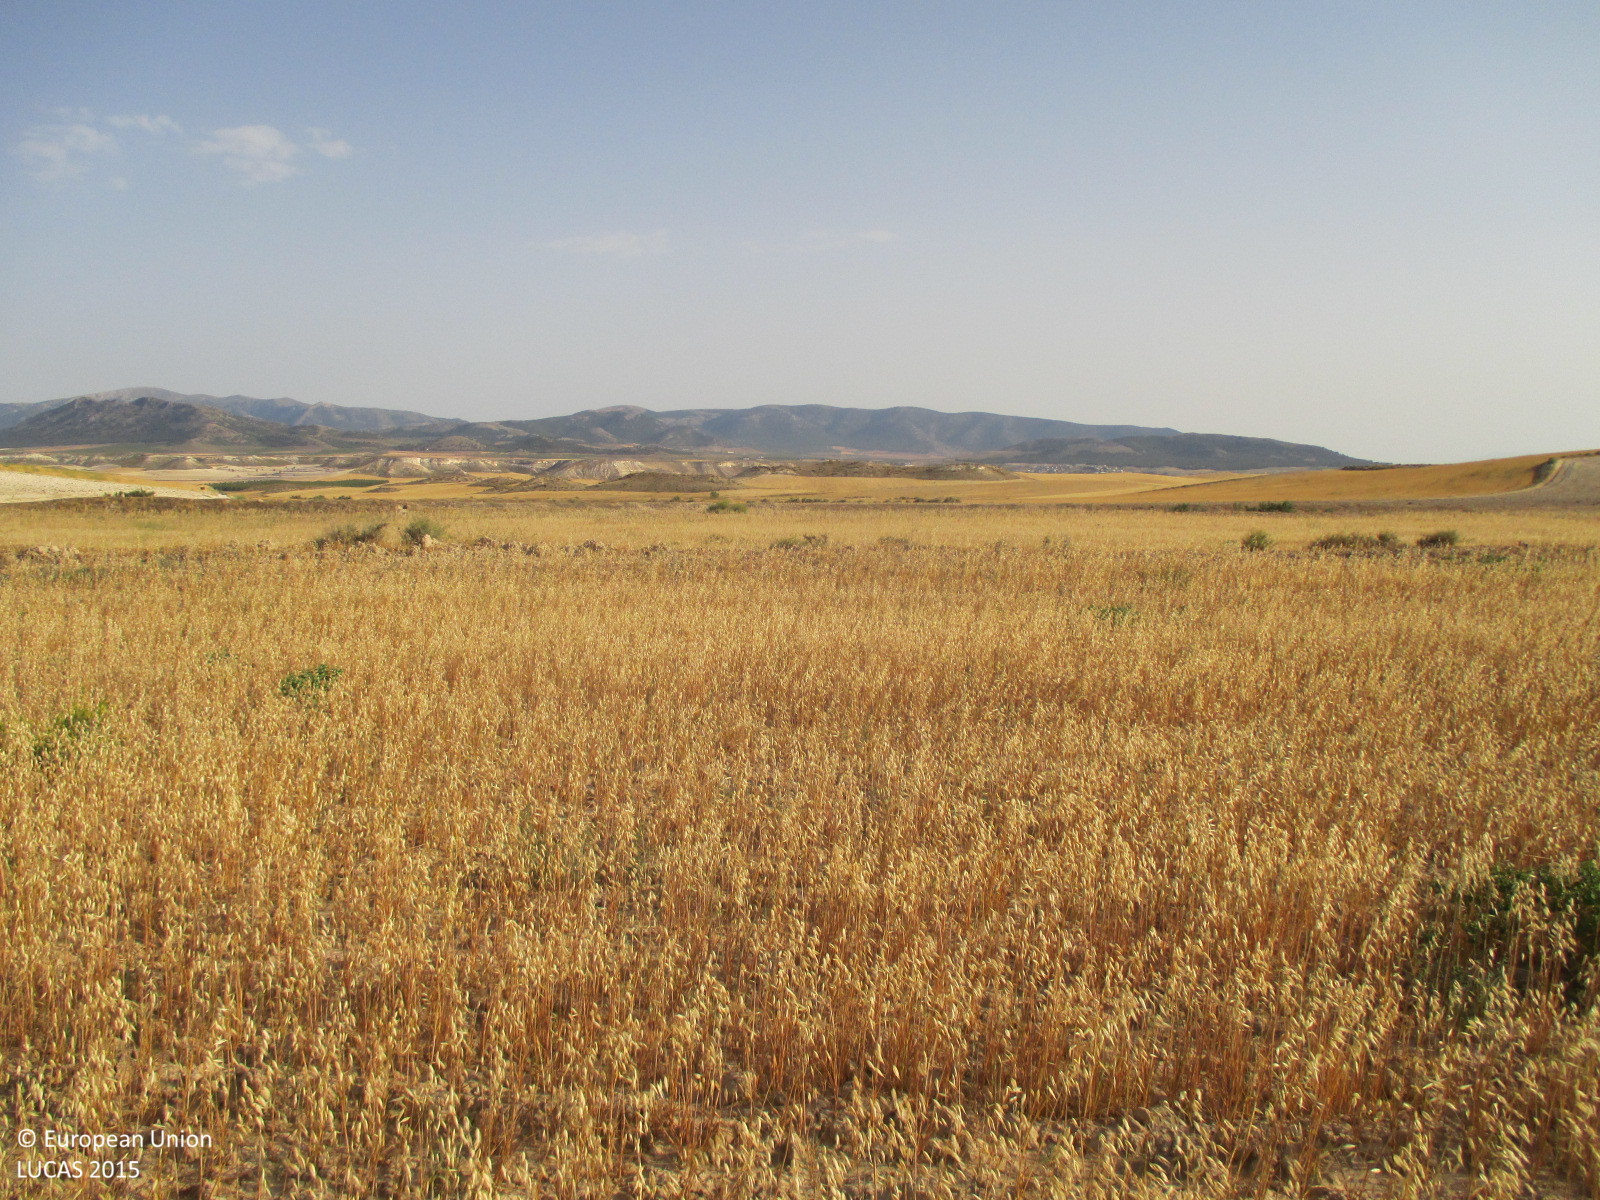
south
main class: Cropland
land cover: Oats
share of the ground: 25 - 50 %
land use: Agriculture (excluding fallow land and kitchen gardens)
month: June
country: ES
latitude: 37.7669
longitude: -2.4647
